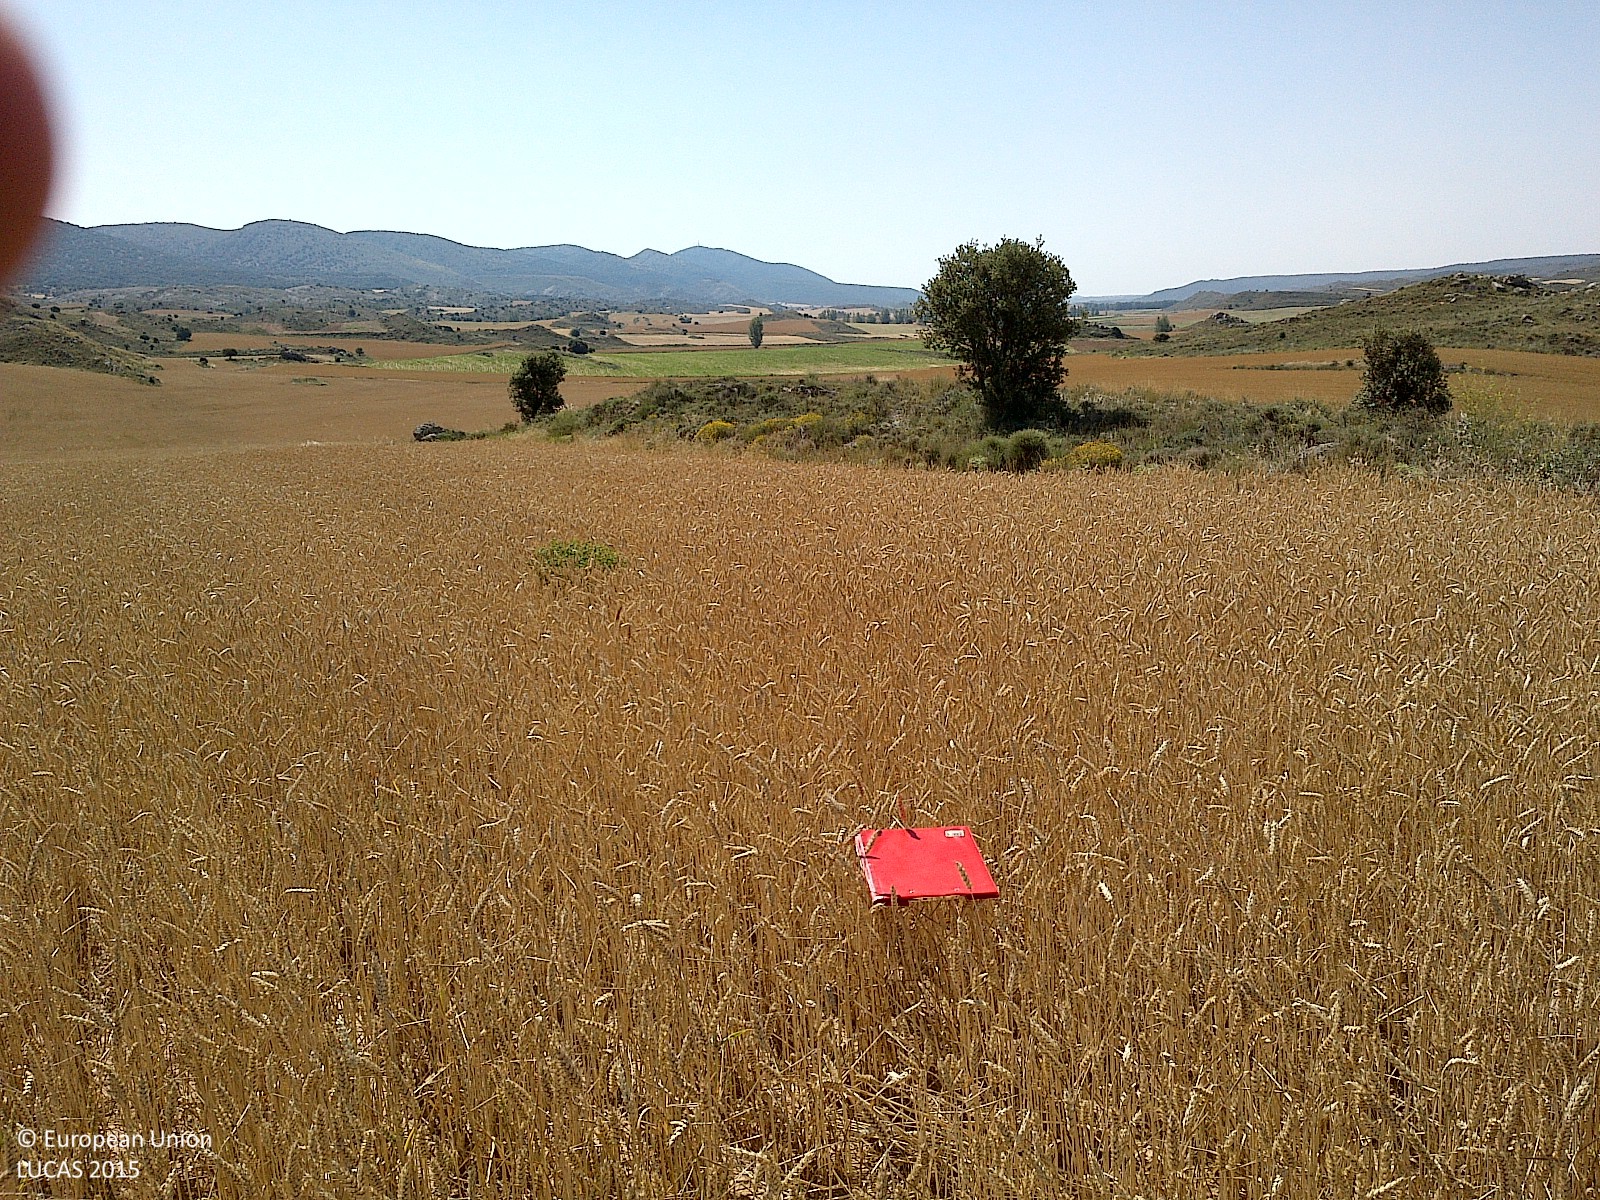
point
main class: Cropland
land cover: Common wheat
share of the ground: > 75 %
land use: Agriculture (excluding fallow land and kitchen gardens)
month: July
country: ES
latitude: 41.5572
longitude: -2.1301
